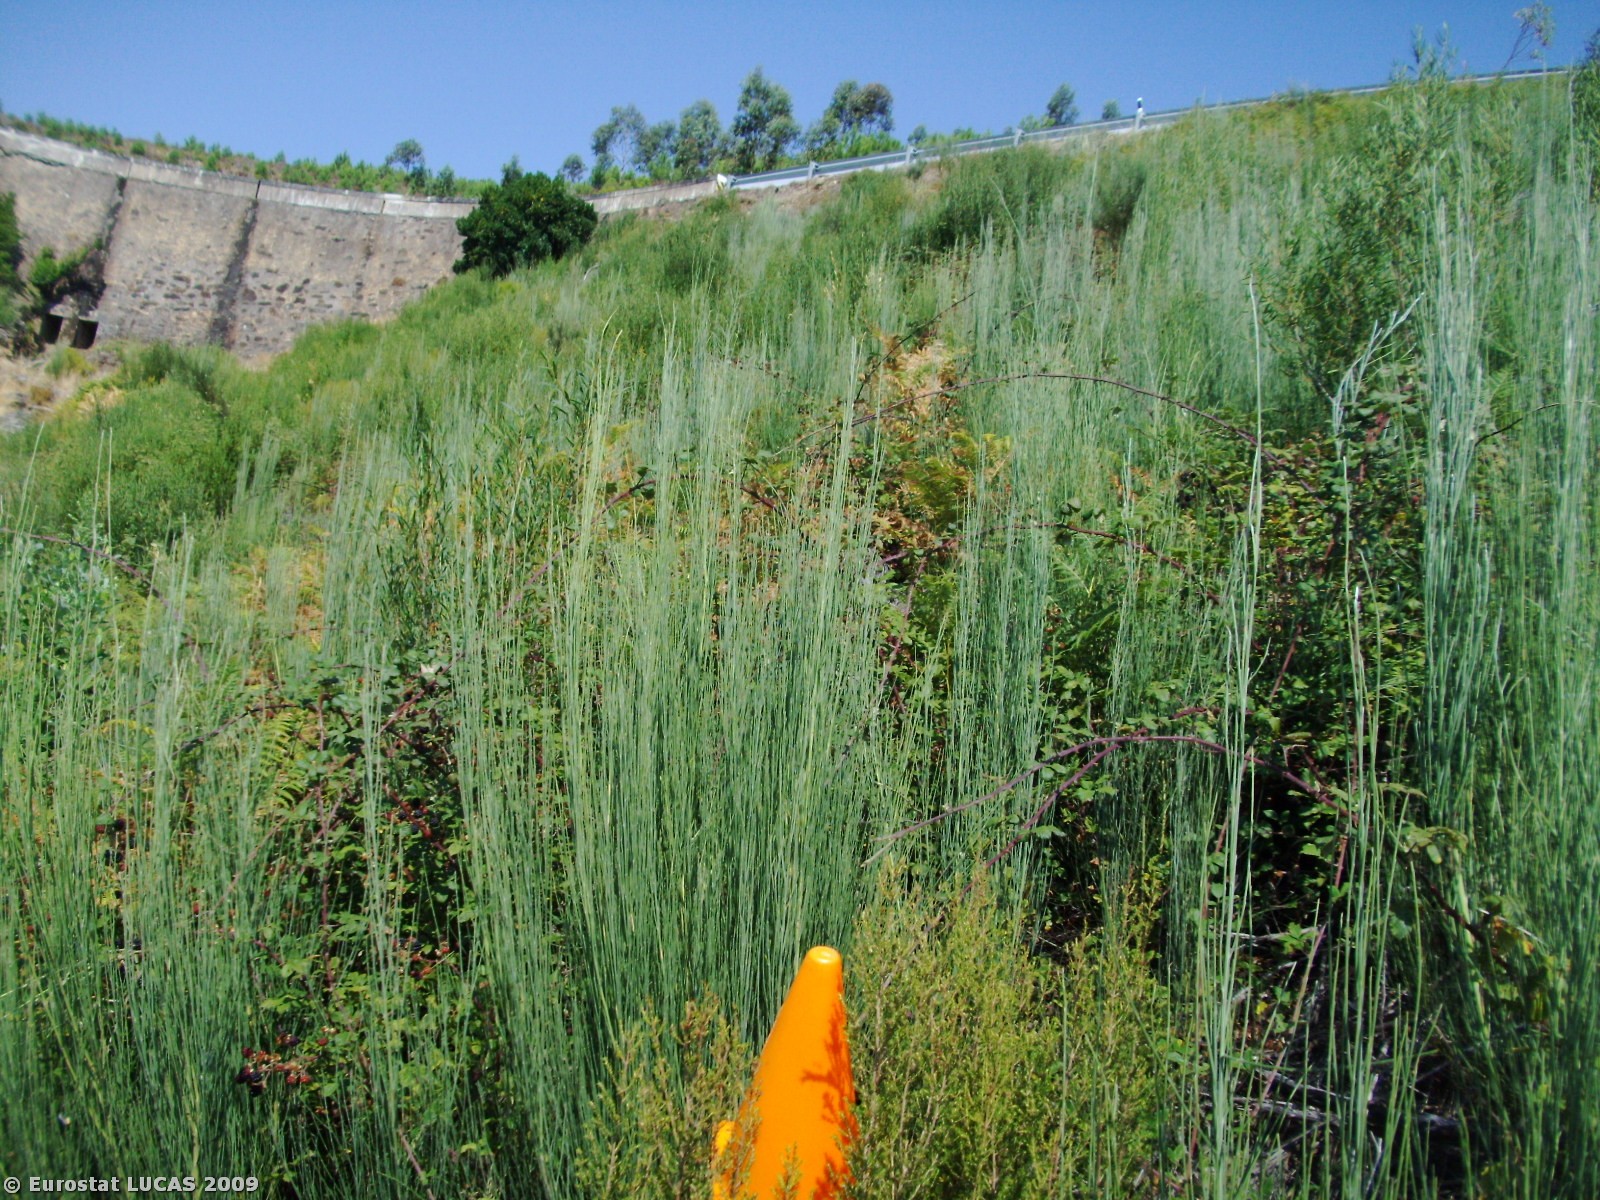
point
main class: Shrubland
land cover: Shrubland without tree cover
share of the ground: > 75 %
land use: Forestry
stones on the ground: > 50 %
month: August
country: PT
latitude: 40.2389
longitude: -7.6597
